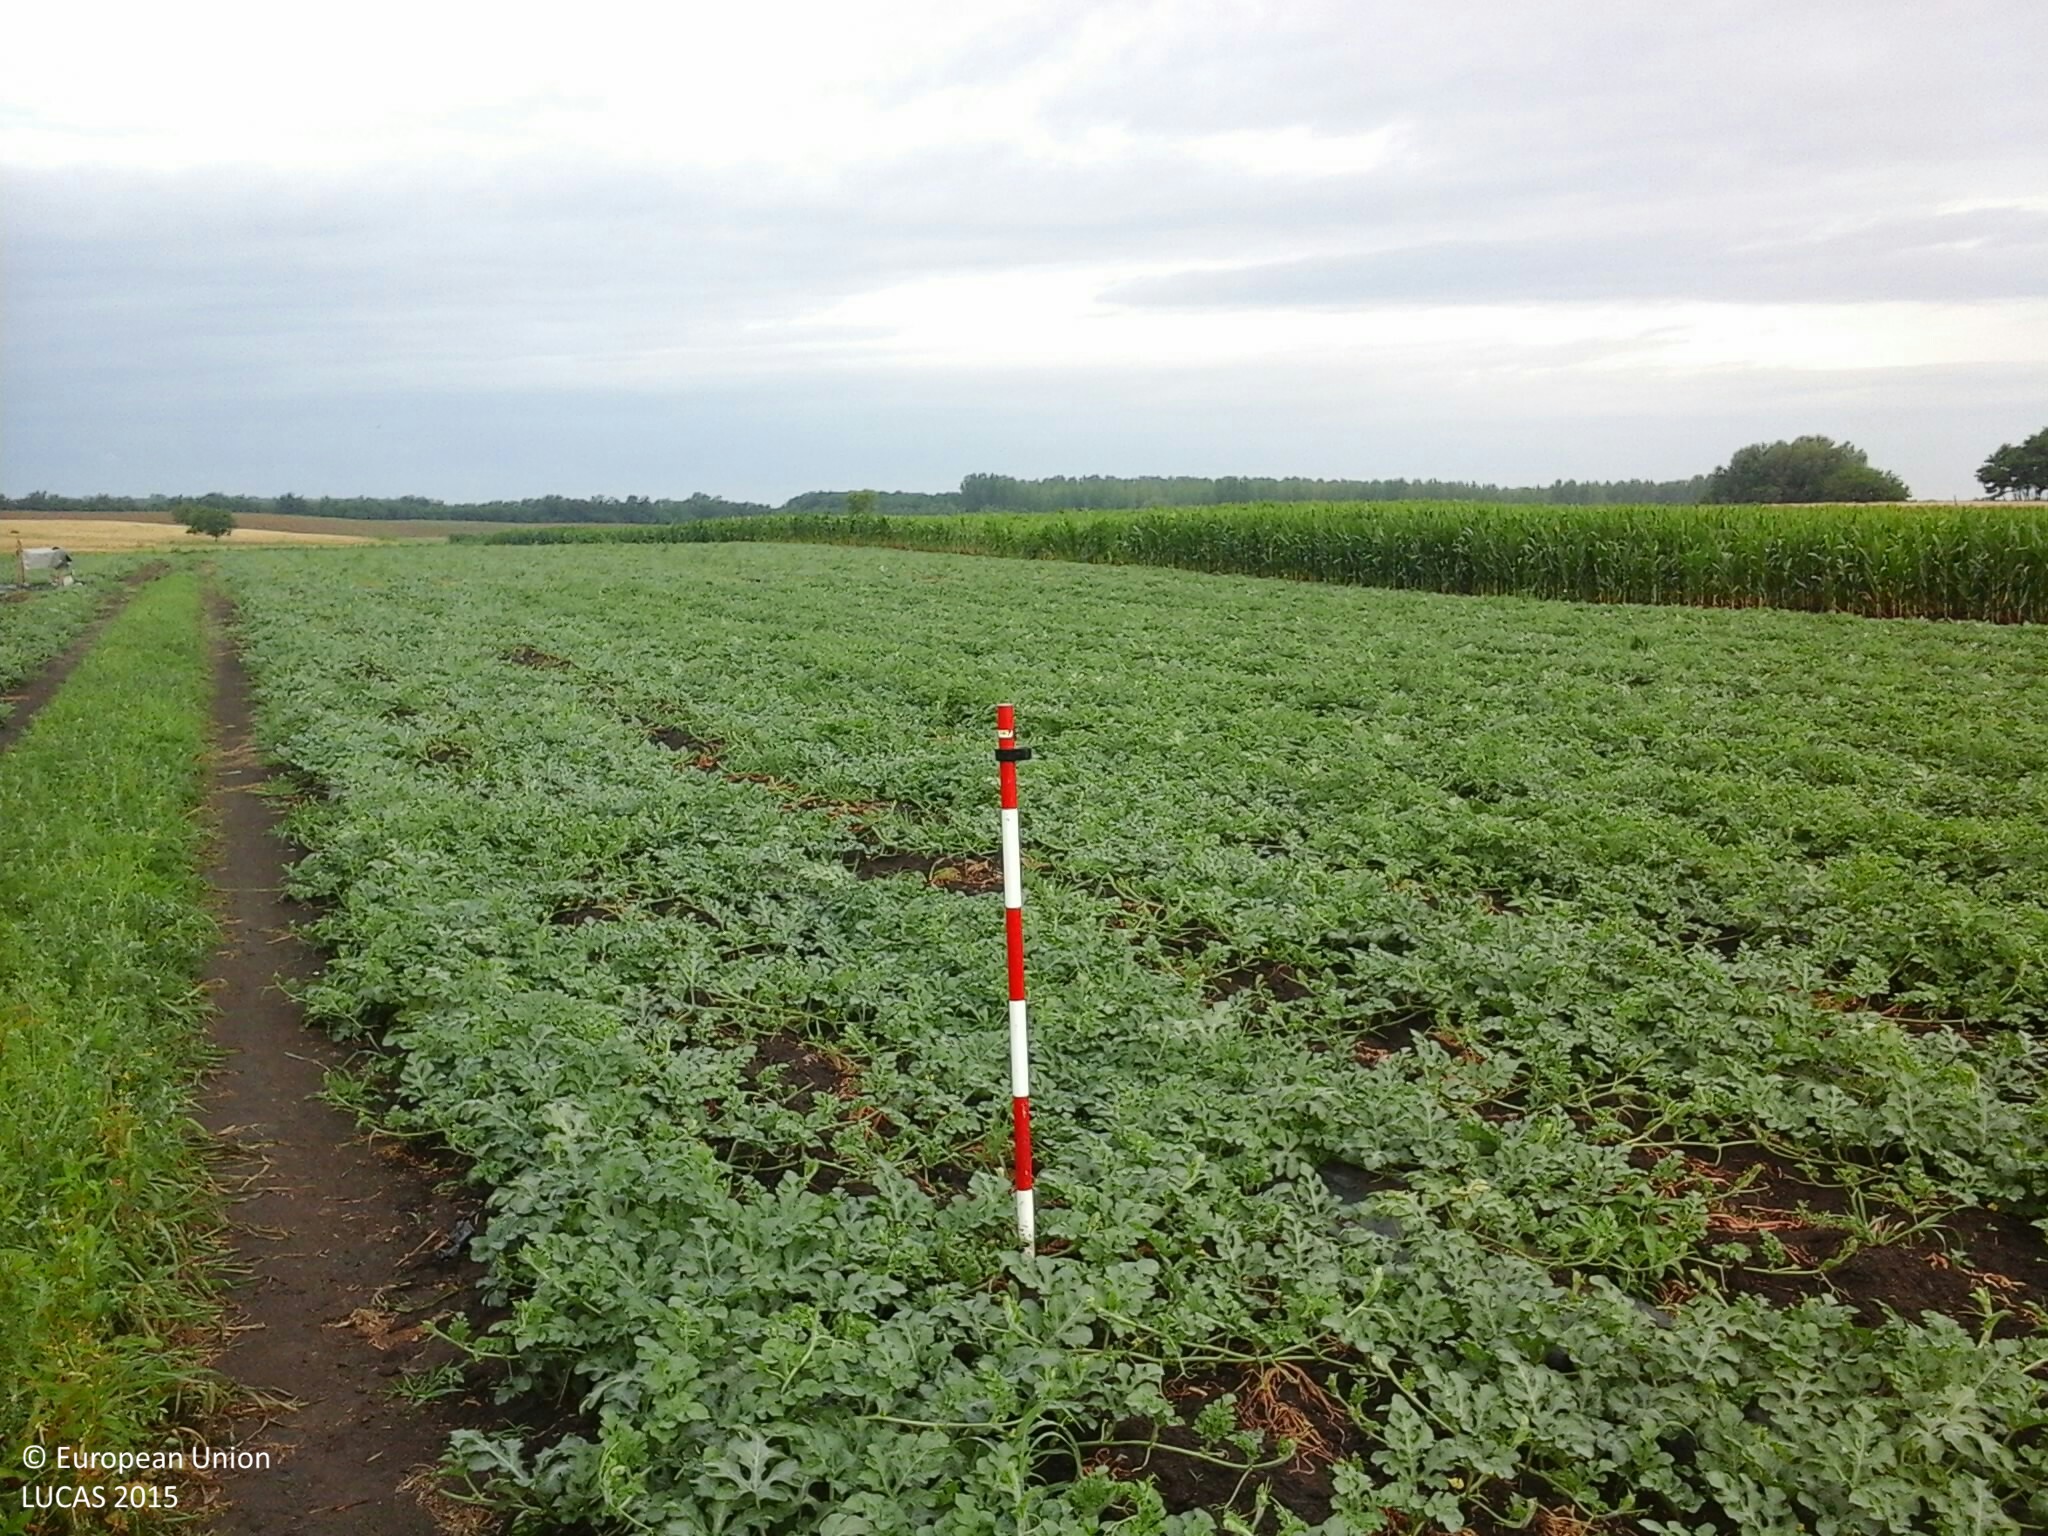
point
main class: Cropland
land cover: Other fresh vegetables
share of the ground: 50 - 75 %
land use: Agriculture (excluding fallow land and kitchen gardens)
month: July
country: HU
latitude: 47.8133
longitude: 21.8952
